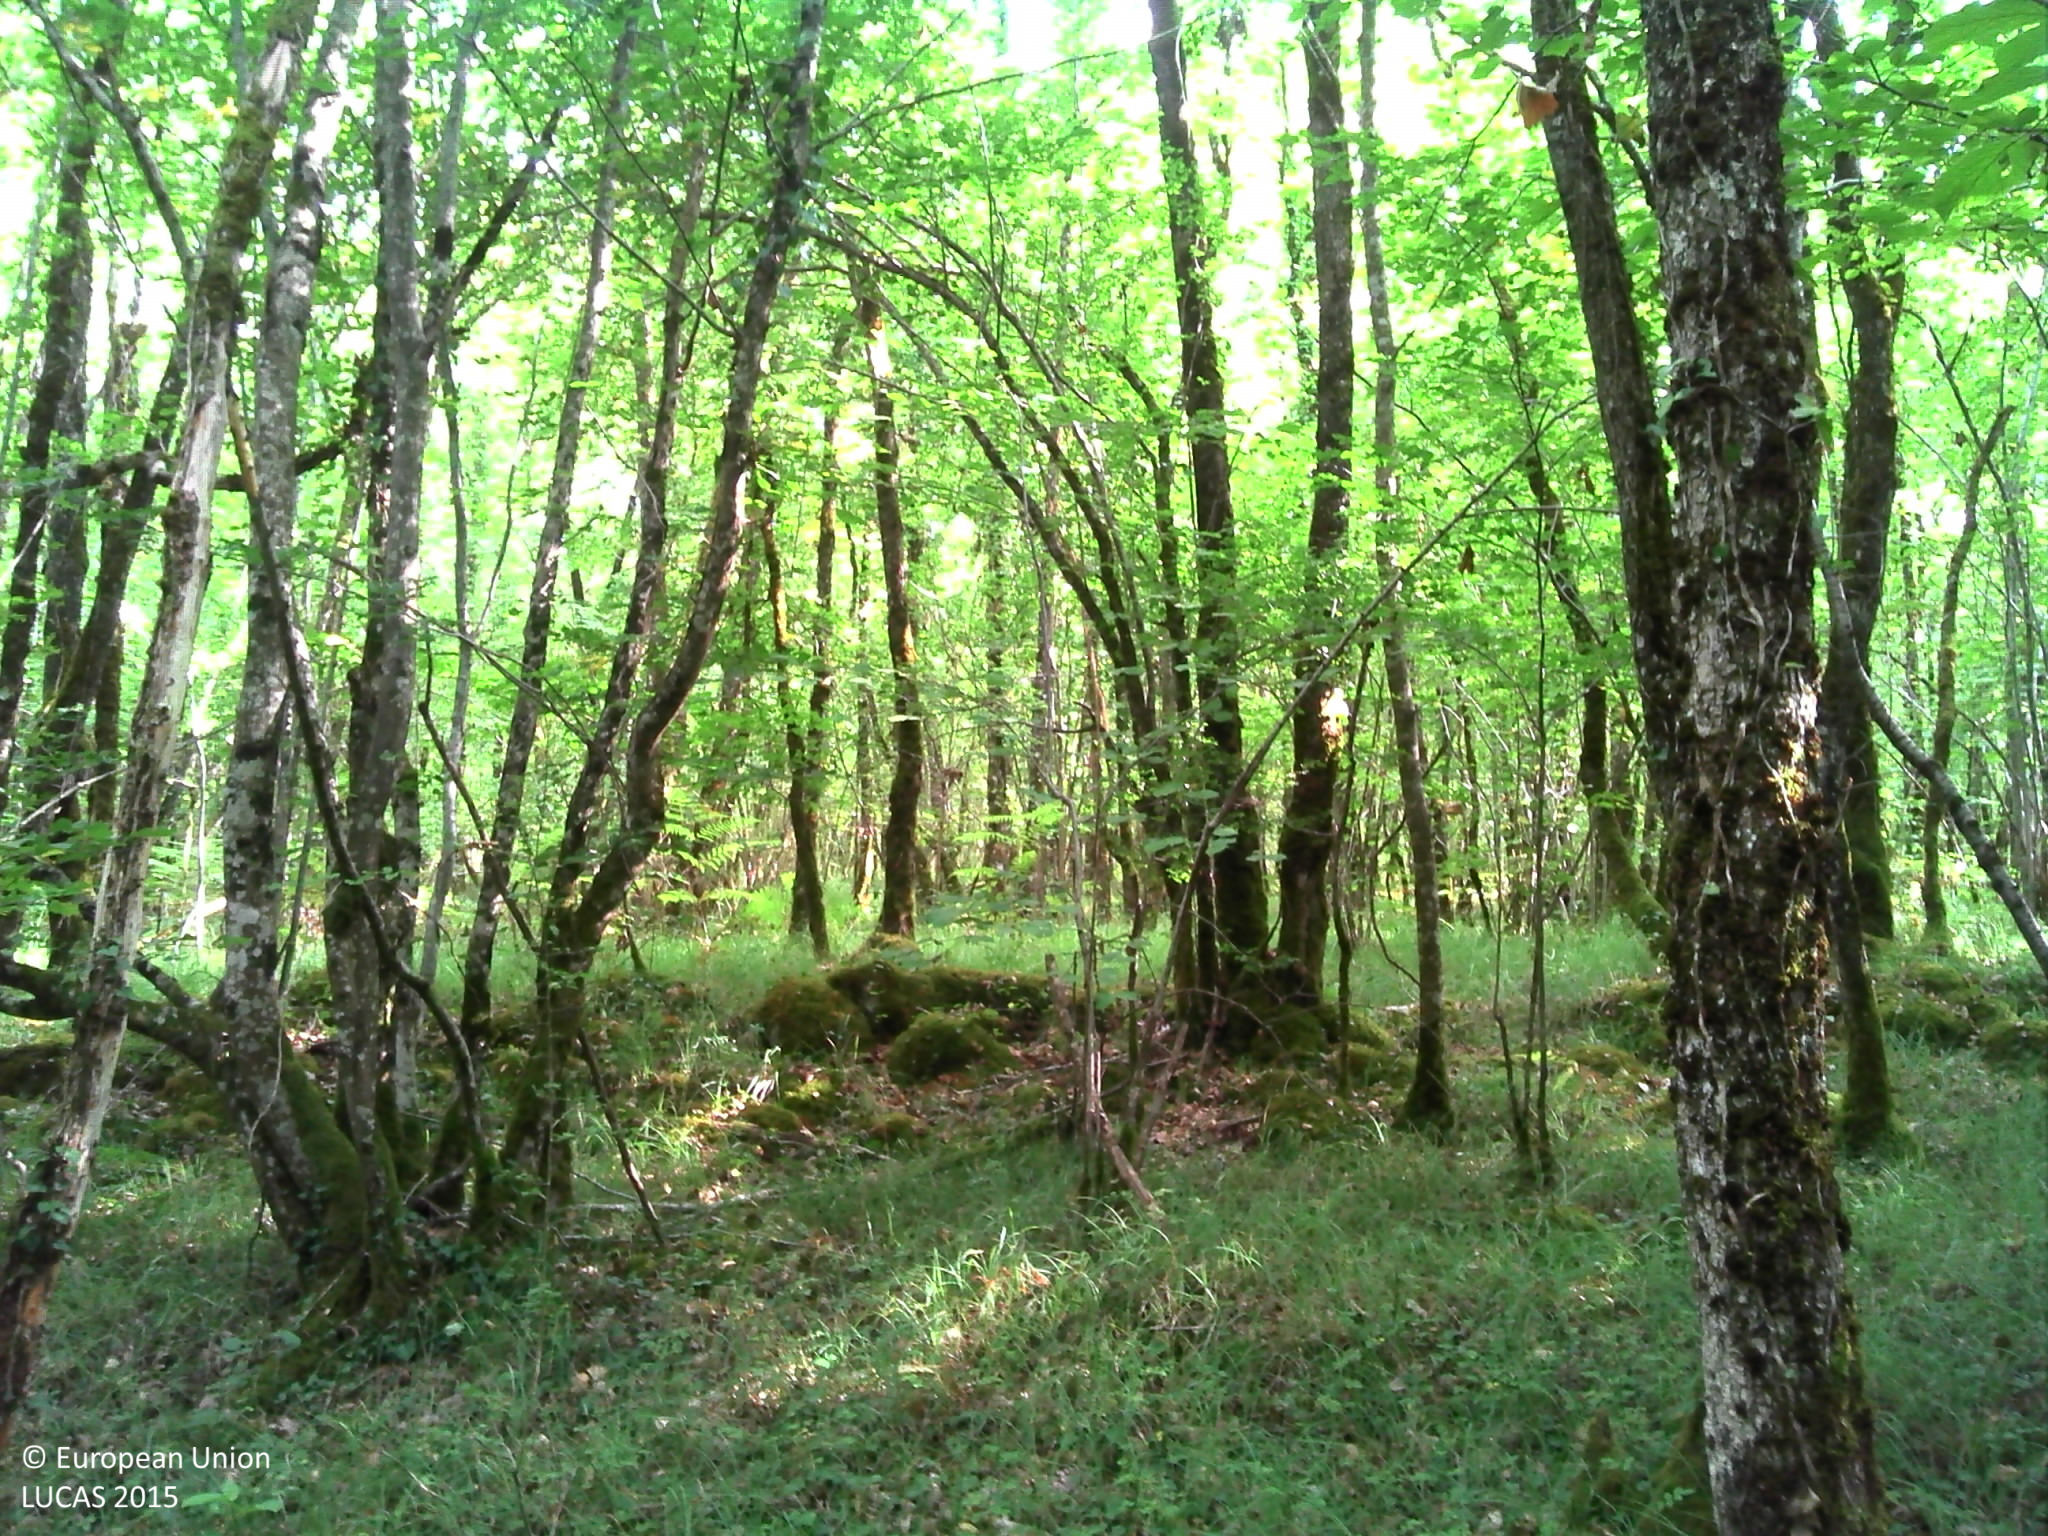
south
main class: Woodland
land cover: Broadleaved woodland
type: mesophytic deciduous forest
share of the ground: > 75 %
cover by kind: broadleaved forest trees 70 %, herbaceous plants 20 %, shrubs 5 %, lichens and mosses 5 %
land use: Forestry
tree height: > 5 m
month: August
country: FR
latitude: 45.4479
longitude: 0.4100
